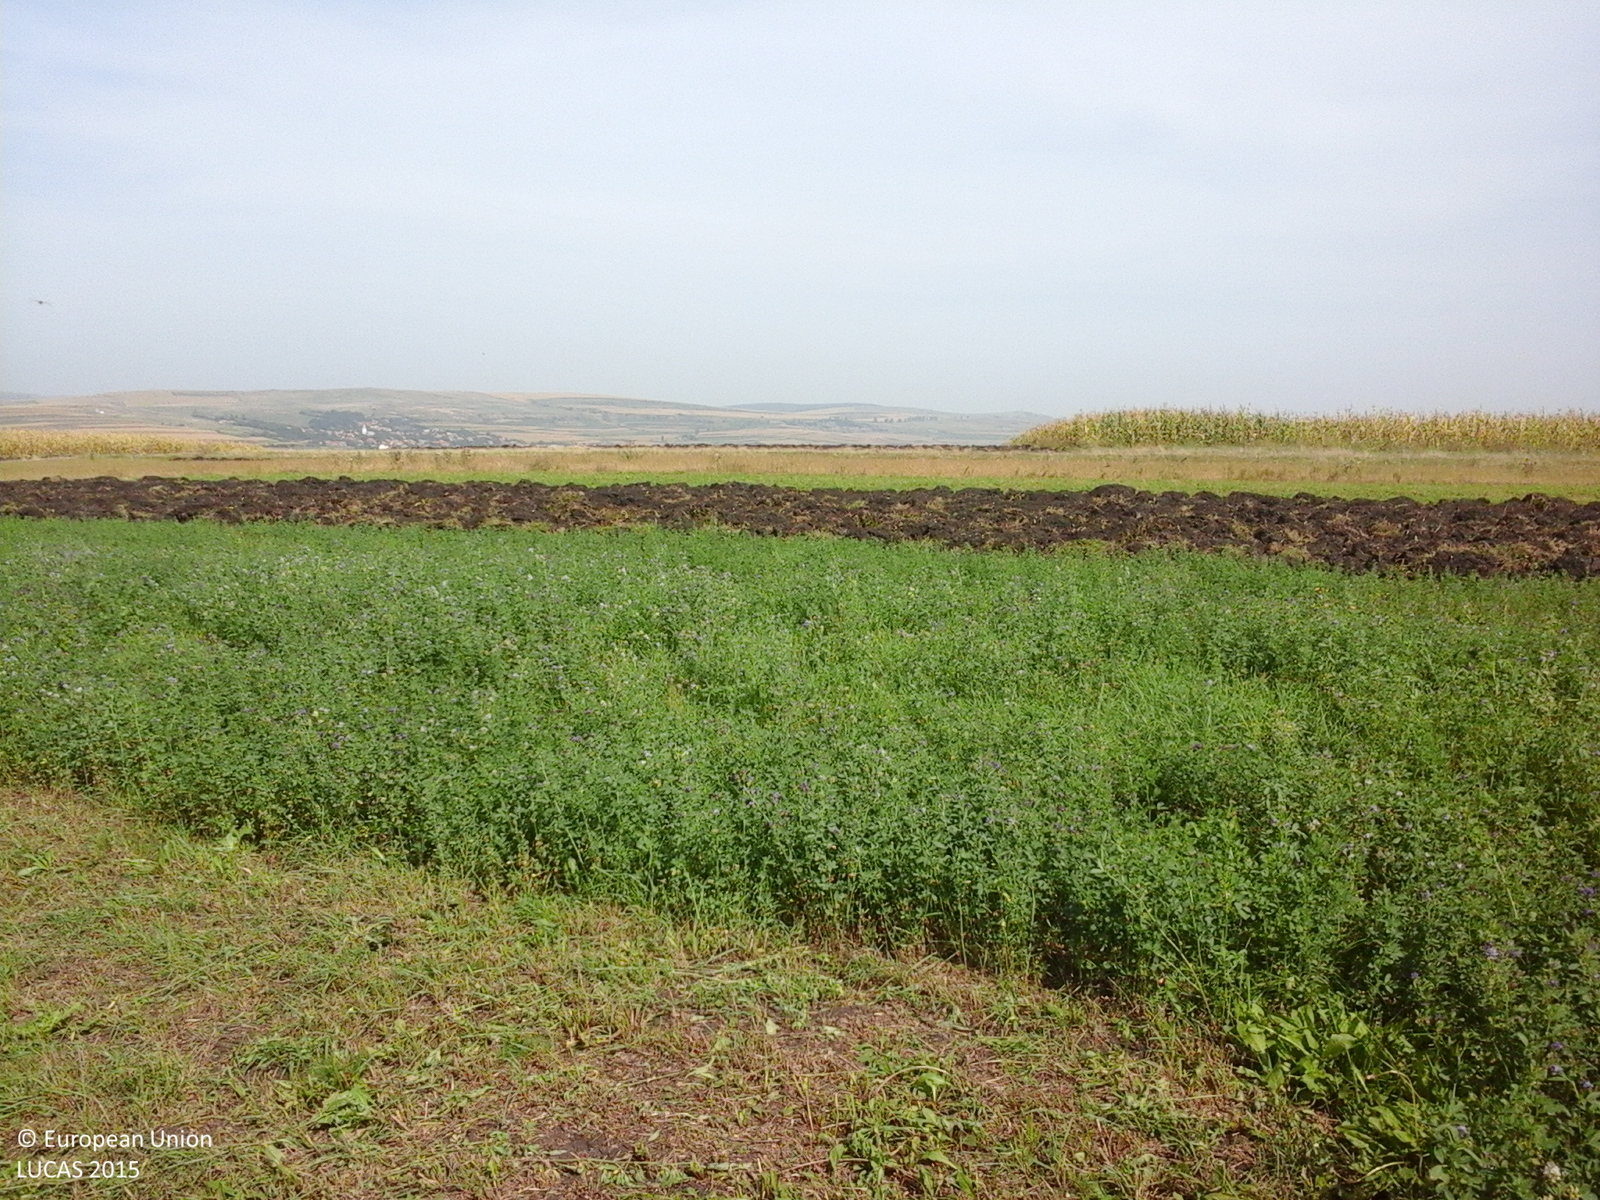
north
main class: Cropland
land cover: Lucerne
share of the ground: > 75 %
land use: Agriculture (excluding fallow land and kitchen gardens)
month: September
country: RO
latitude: 46.6127
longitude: 23.7171
